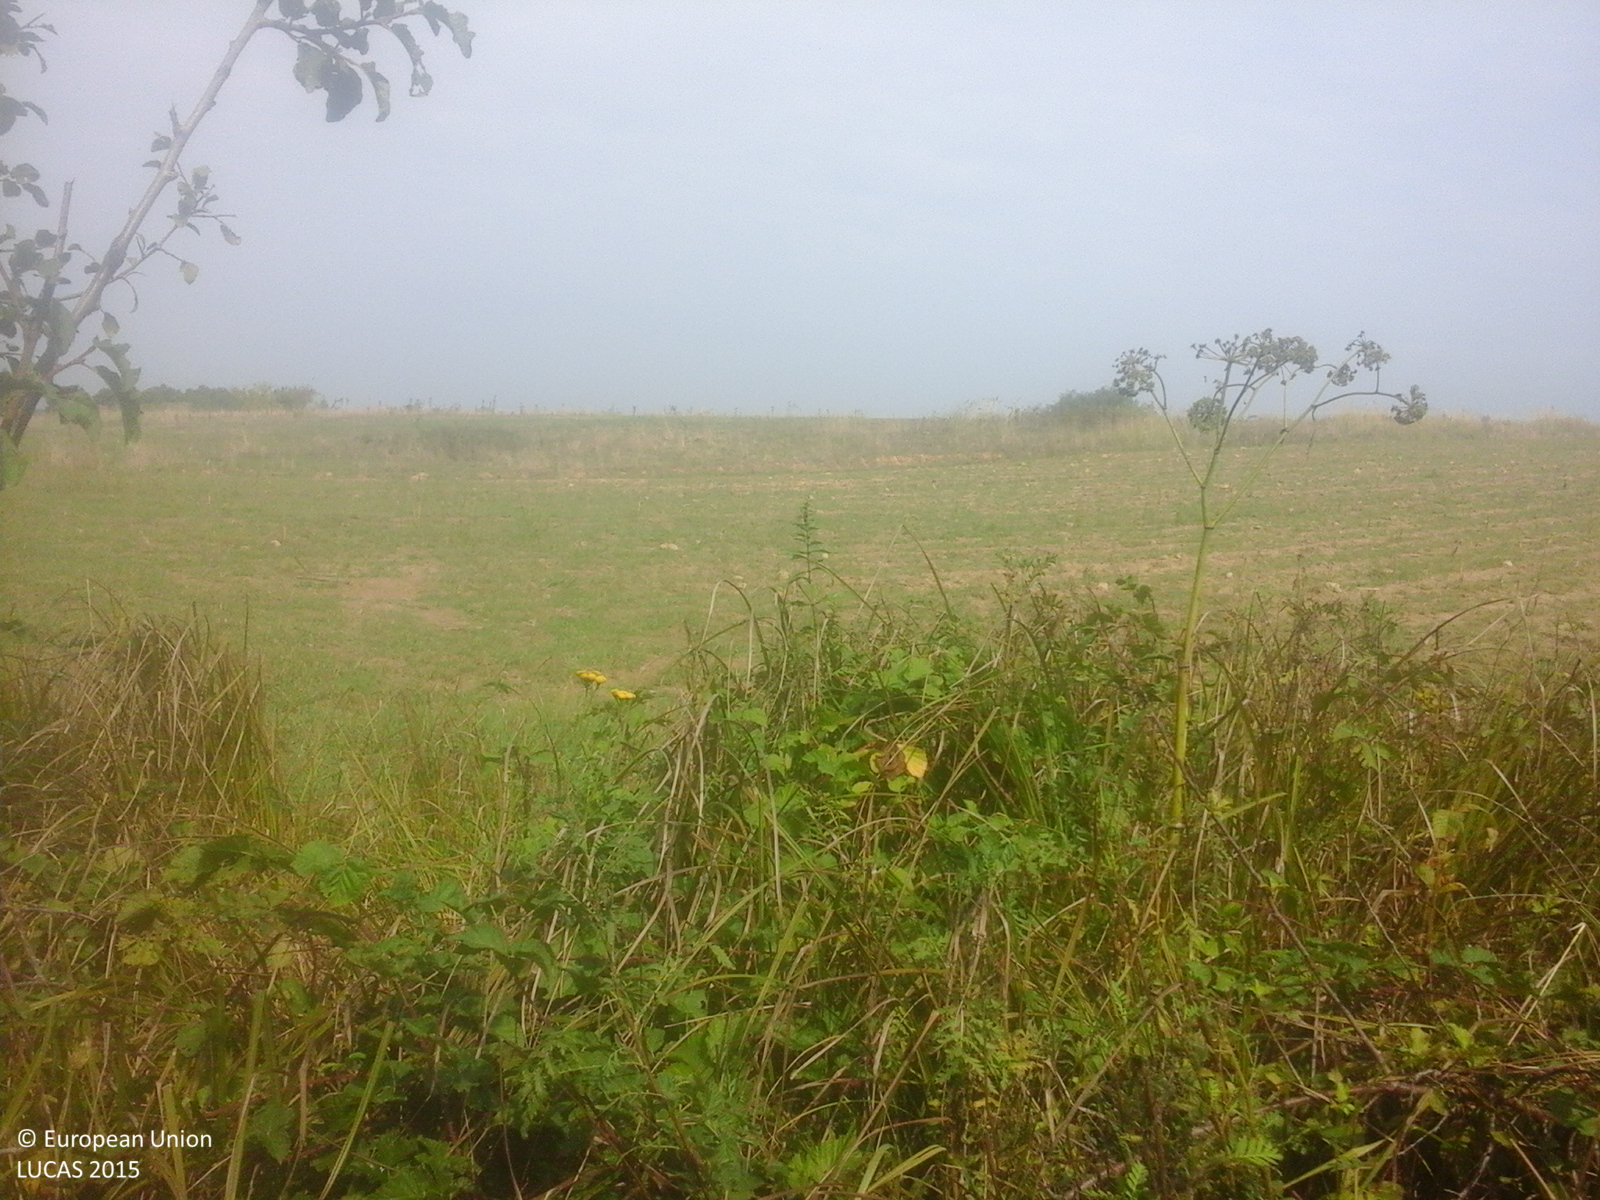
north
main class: Shrubland
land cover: Shrubland with sparse tree cover
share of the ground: > 75 %
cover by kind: shrubs 95 %, broadleaved forest trees 5 %
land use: Forestry
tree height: < 5 m
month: September
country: RO
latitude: 45.8191
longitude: 22.1537
